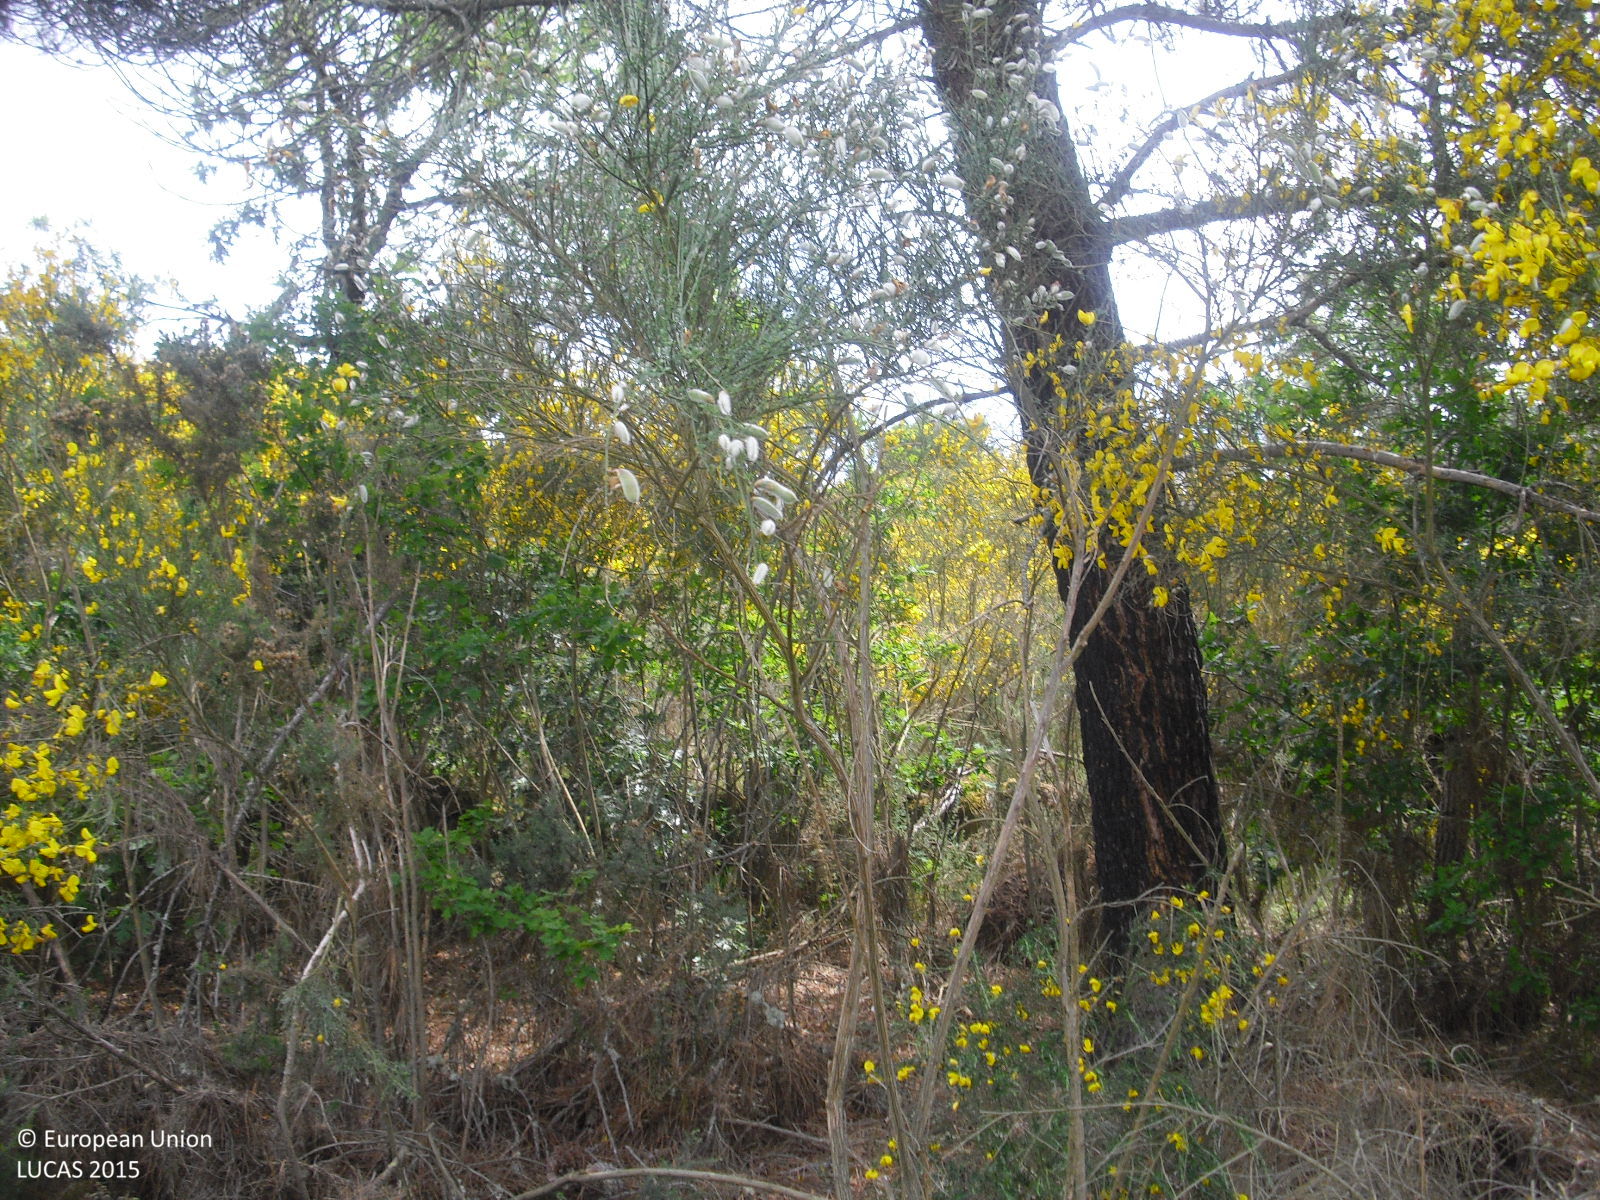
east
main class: Woodland
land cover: Pine dominated mixed woodland
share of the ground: 50 - 75 %
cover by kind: coniferous forest trees 50 %, shrubs 30 %, broadleaved forest trees 20 %
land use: Forestry
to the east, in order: Pine dominated mixed woodland; Dry stone walls; Shrubland without tree cover; Grassland with sparse tree/shrub cover; Shrubland with sparse tree cover; Rock outcrops; Shrubland with sparse tree cover; Rock outcrops; Shrubland with sparse tree cover; Grass margins; Tracks; Shrubland with sparse tree cover; Rock outcrops; Shrubland with sparse tree cover; Rock outcrops; Grassland with sparse tree/shrub cover
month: May
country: ES
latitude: 42.1553
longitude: -7.8774
